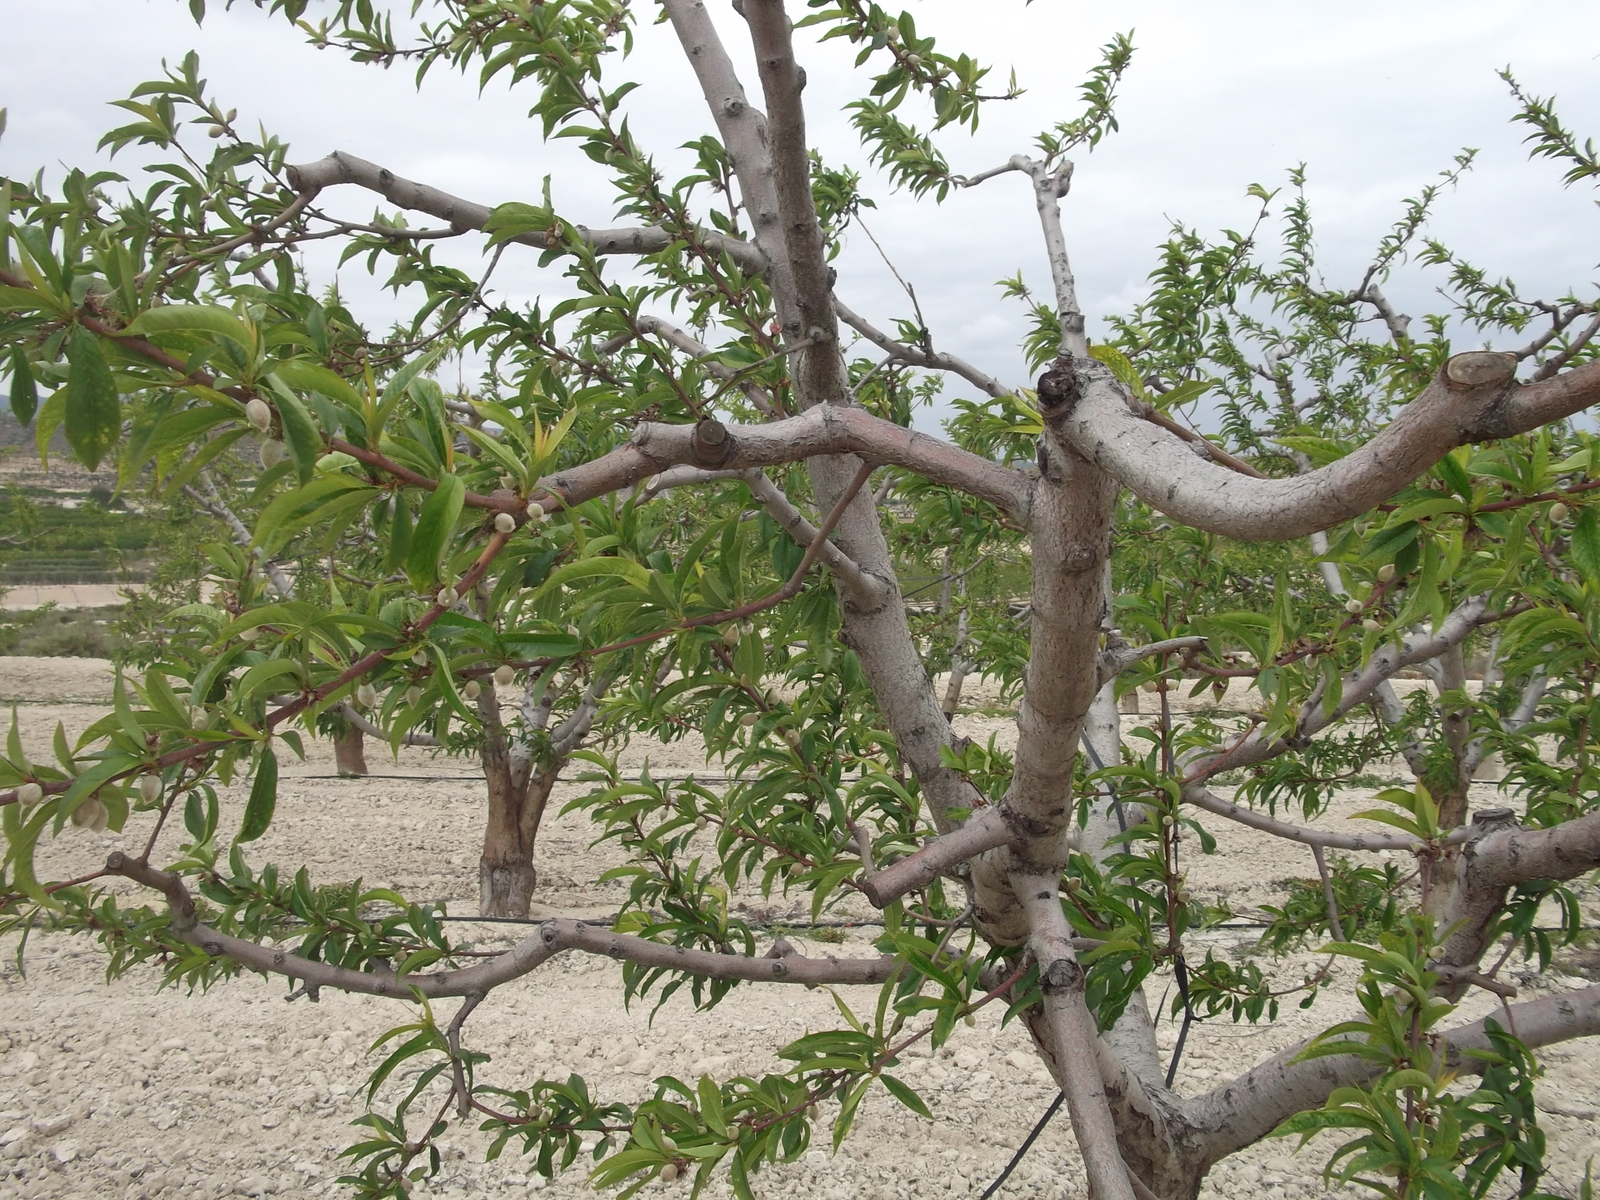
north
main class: Cropland
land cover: Nuts trees
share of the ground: 10 - 25 %
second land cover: Other bare soil
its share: > 75 %
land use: Agriculture (excluding fallow land and kitchen gardens)
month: April
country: ES
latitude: 38.0511
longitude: -1.3703
